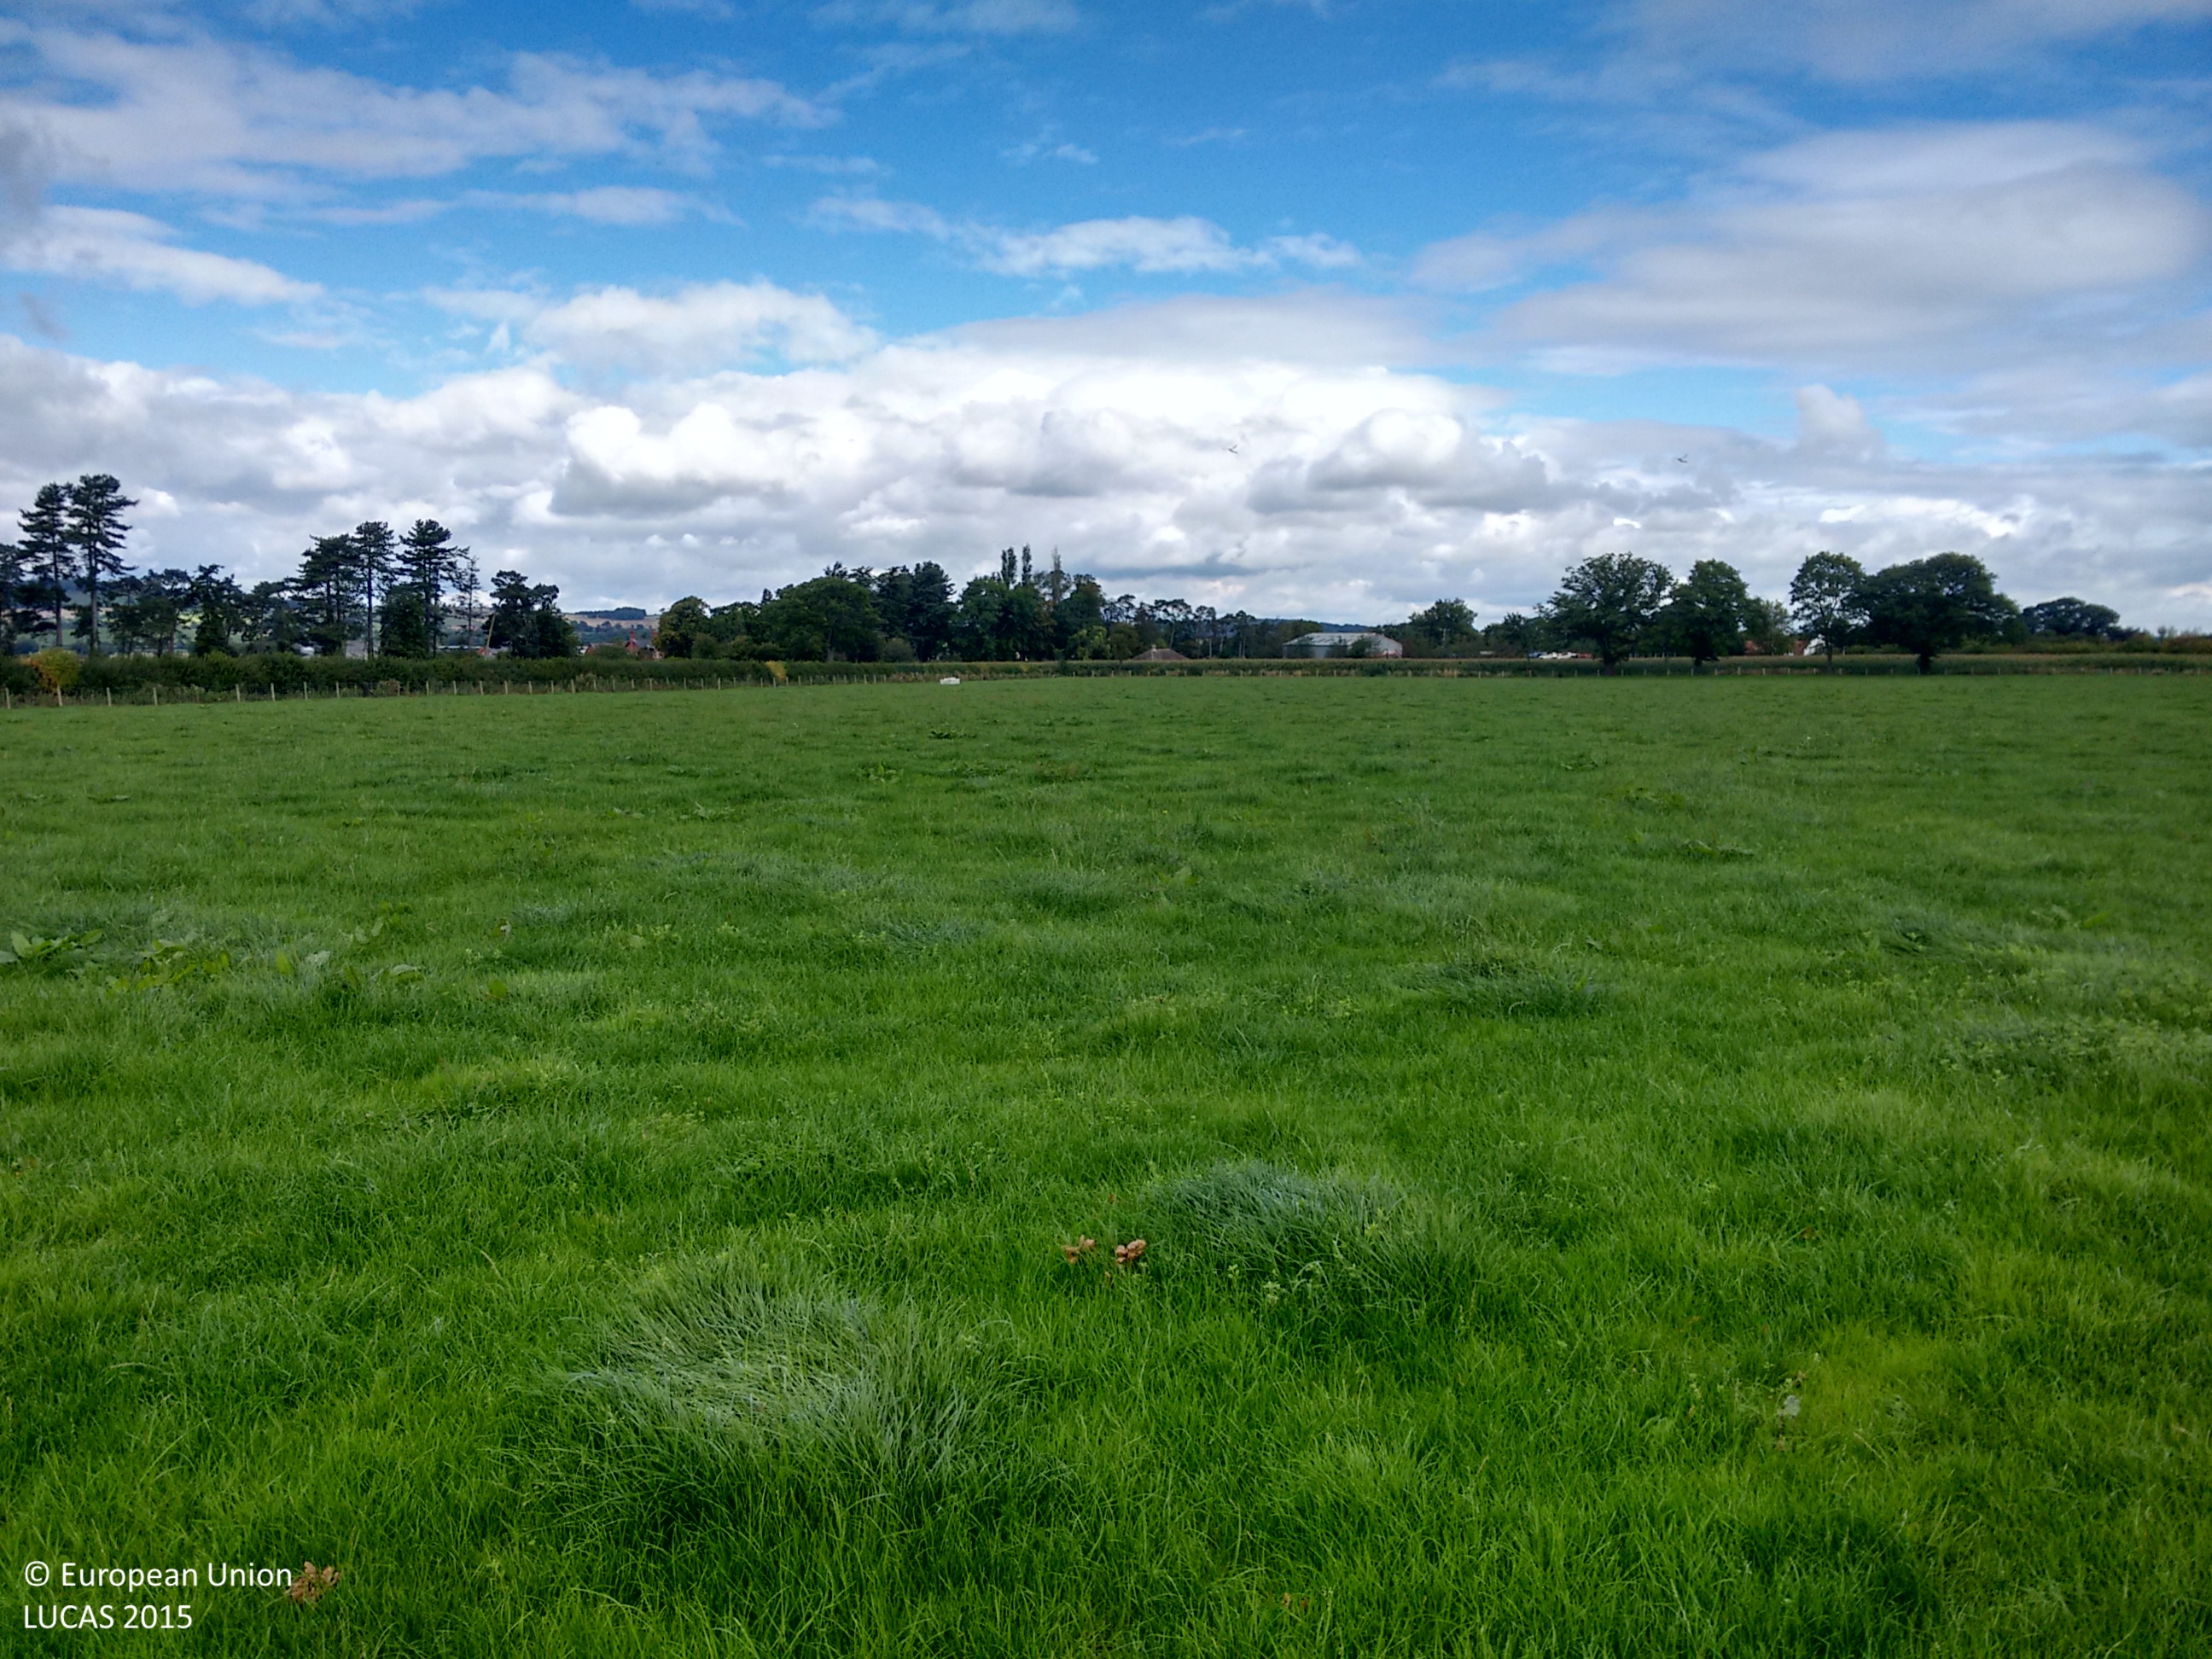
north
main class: Grassland
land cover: Grassland without tree/shrub cover
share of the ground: > 75 %
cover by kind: herbaceous plants 100 %
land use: Agriculture (excluding fallow land and kitchen gardens)
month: September
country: GB
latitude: 52.6307
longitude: -2.9426
